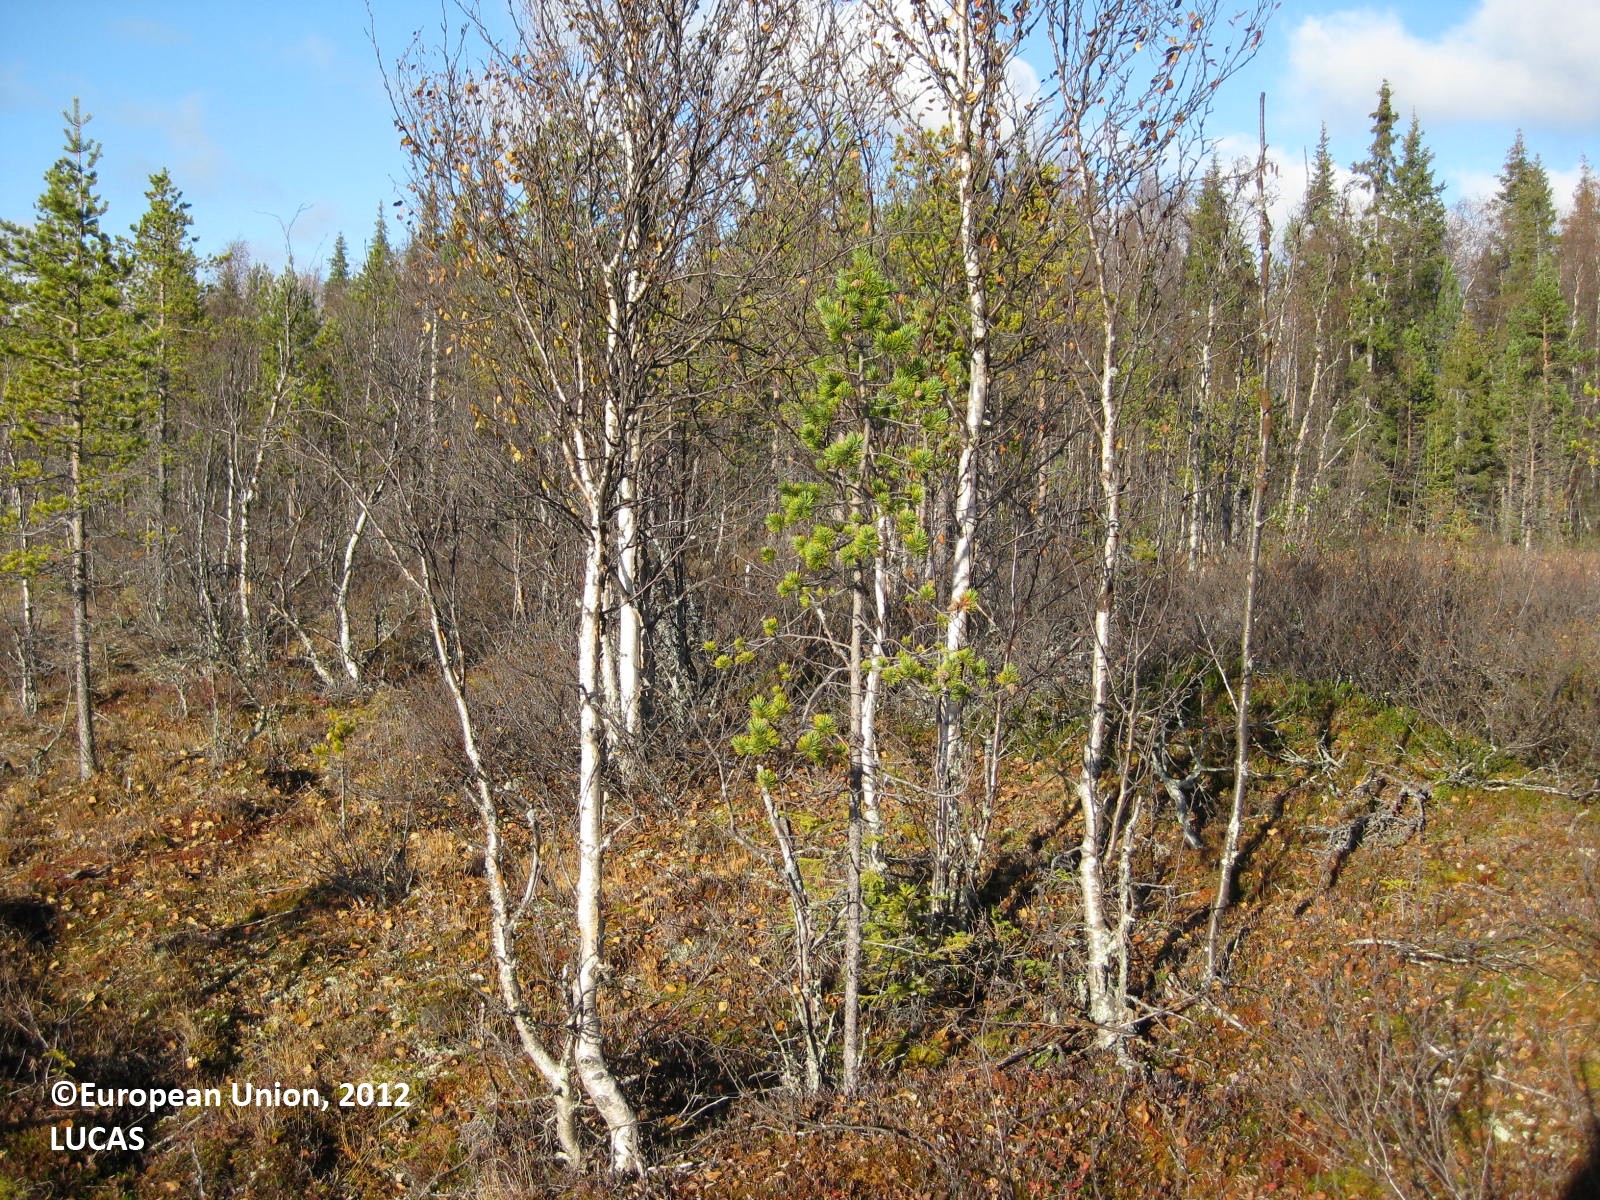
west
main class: Woodland
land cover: Other mixed woodland
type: boreal forest
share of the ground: > 75 %
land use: Forestry
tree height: > 5 m
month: September
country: FI
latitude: 67.9306
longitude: 23.6781
